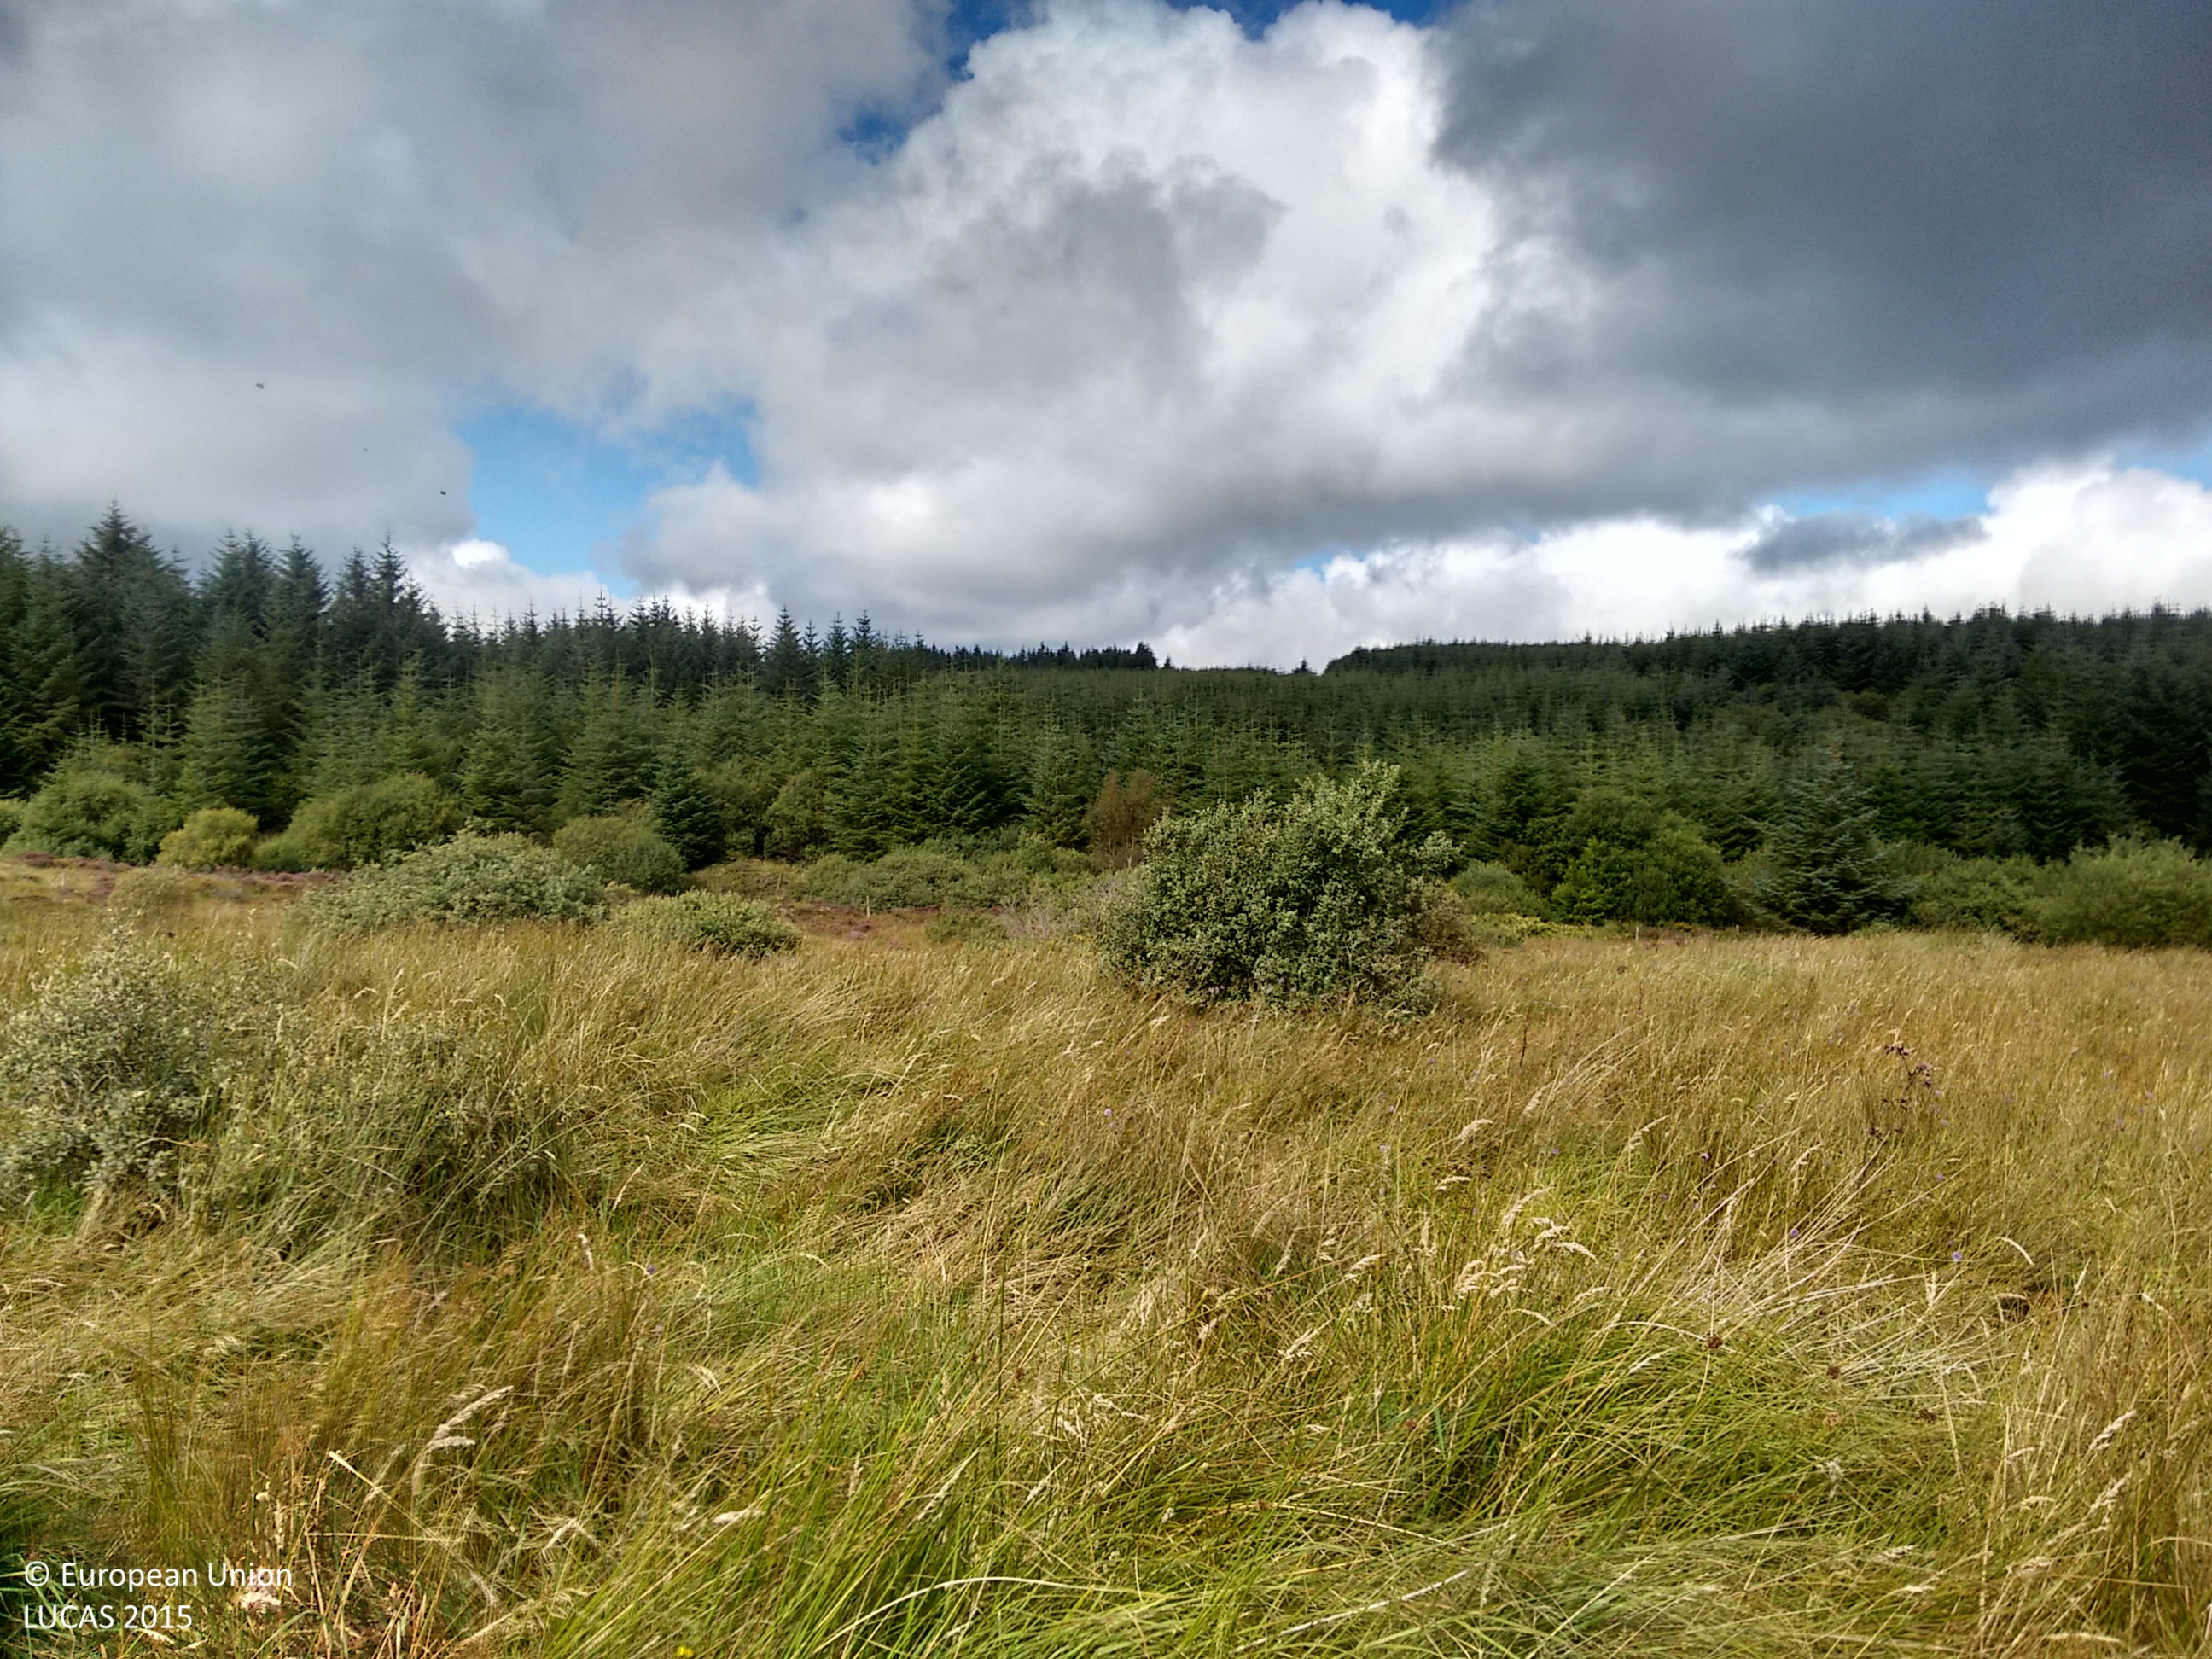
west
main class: Grassland
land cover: Grassland without tree/shrub cover
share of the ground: > 75 %
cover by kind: herbaceous plants 95 %, shrubs 5 %
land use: Agriculture (excluding fallow land and kitchen gardens)
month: September
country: IE
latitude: 52.2755
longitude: -9.3839
